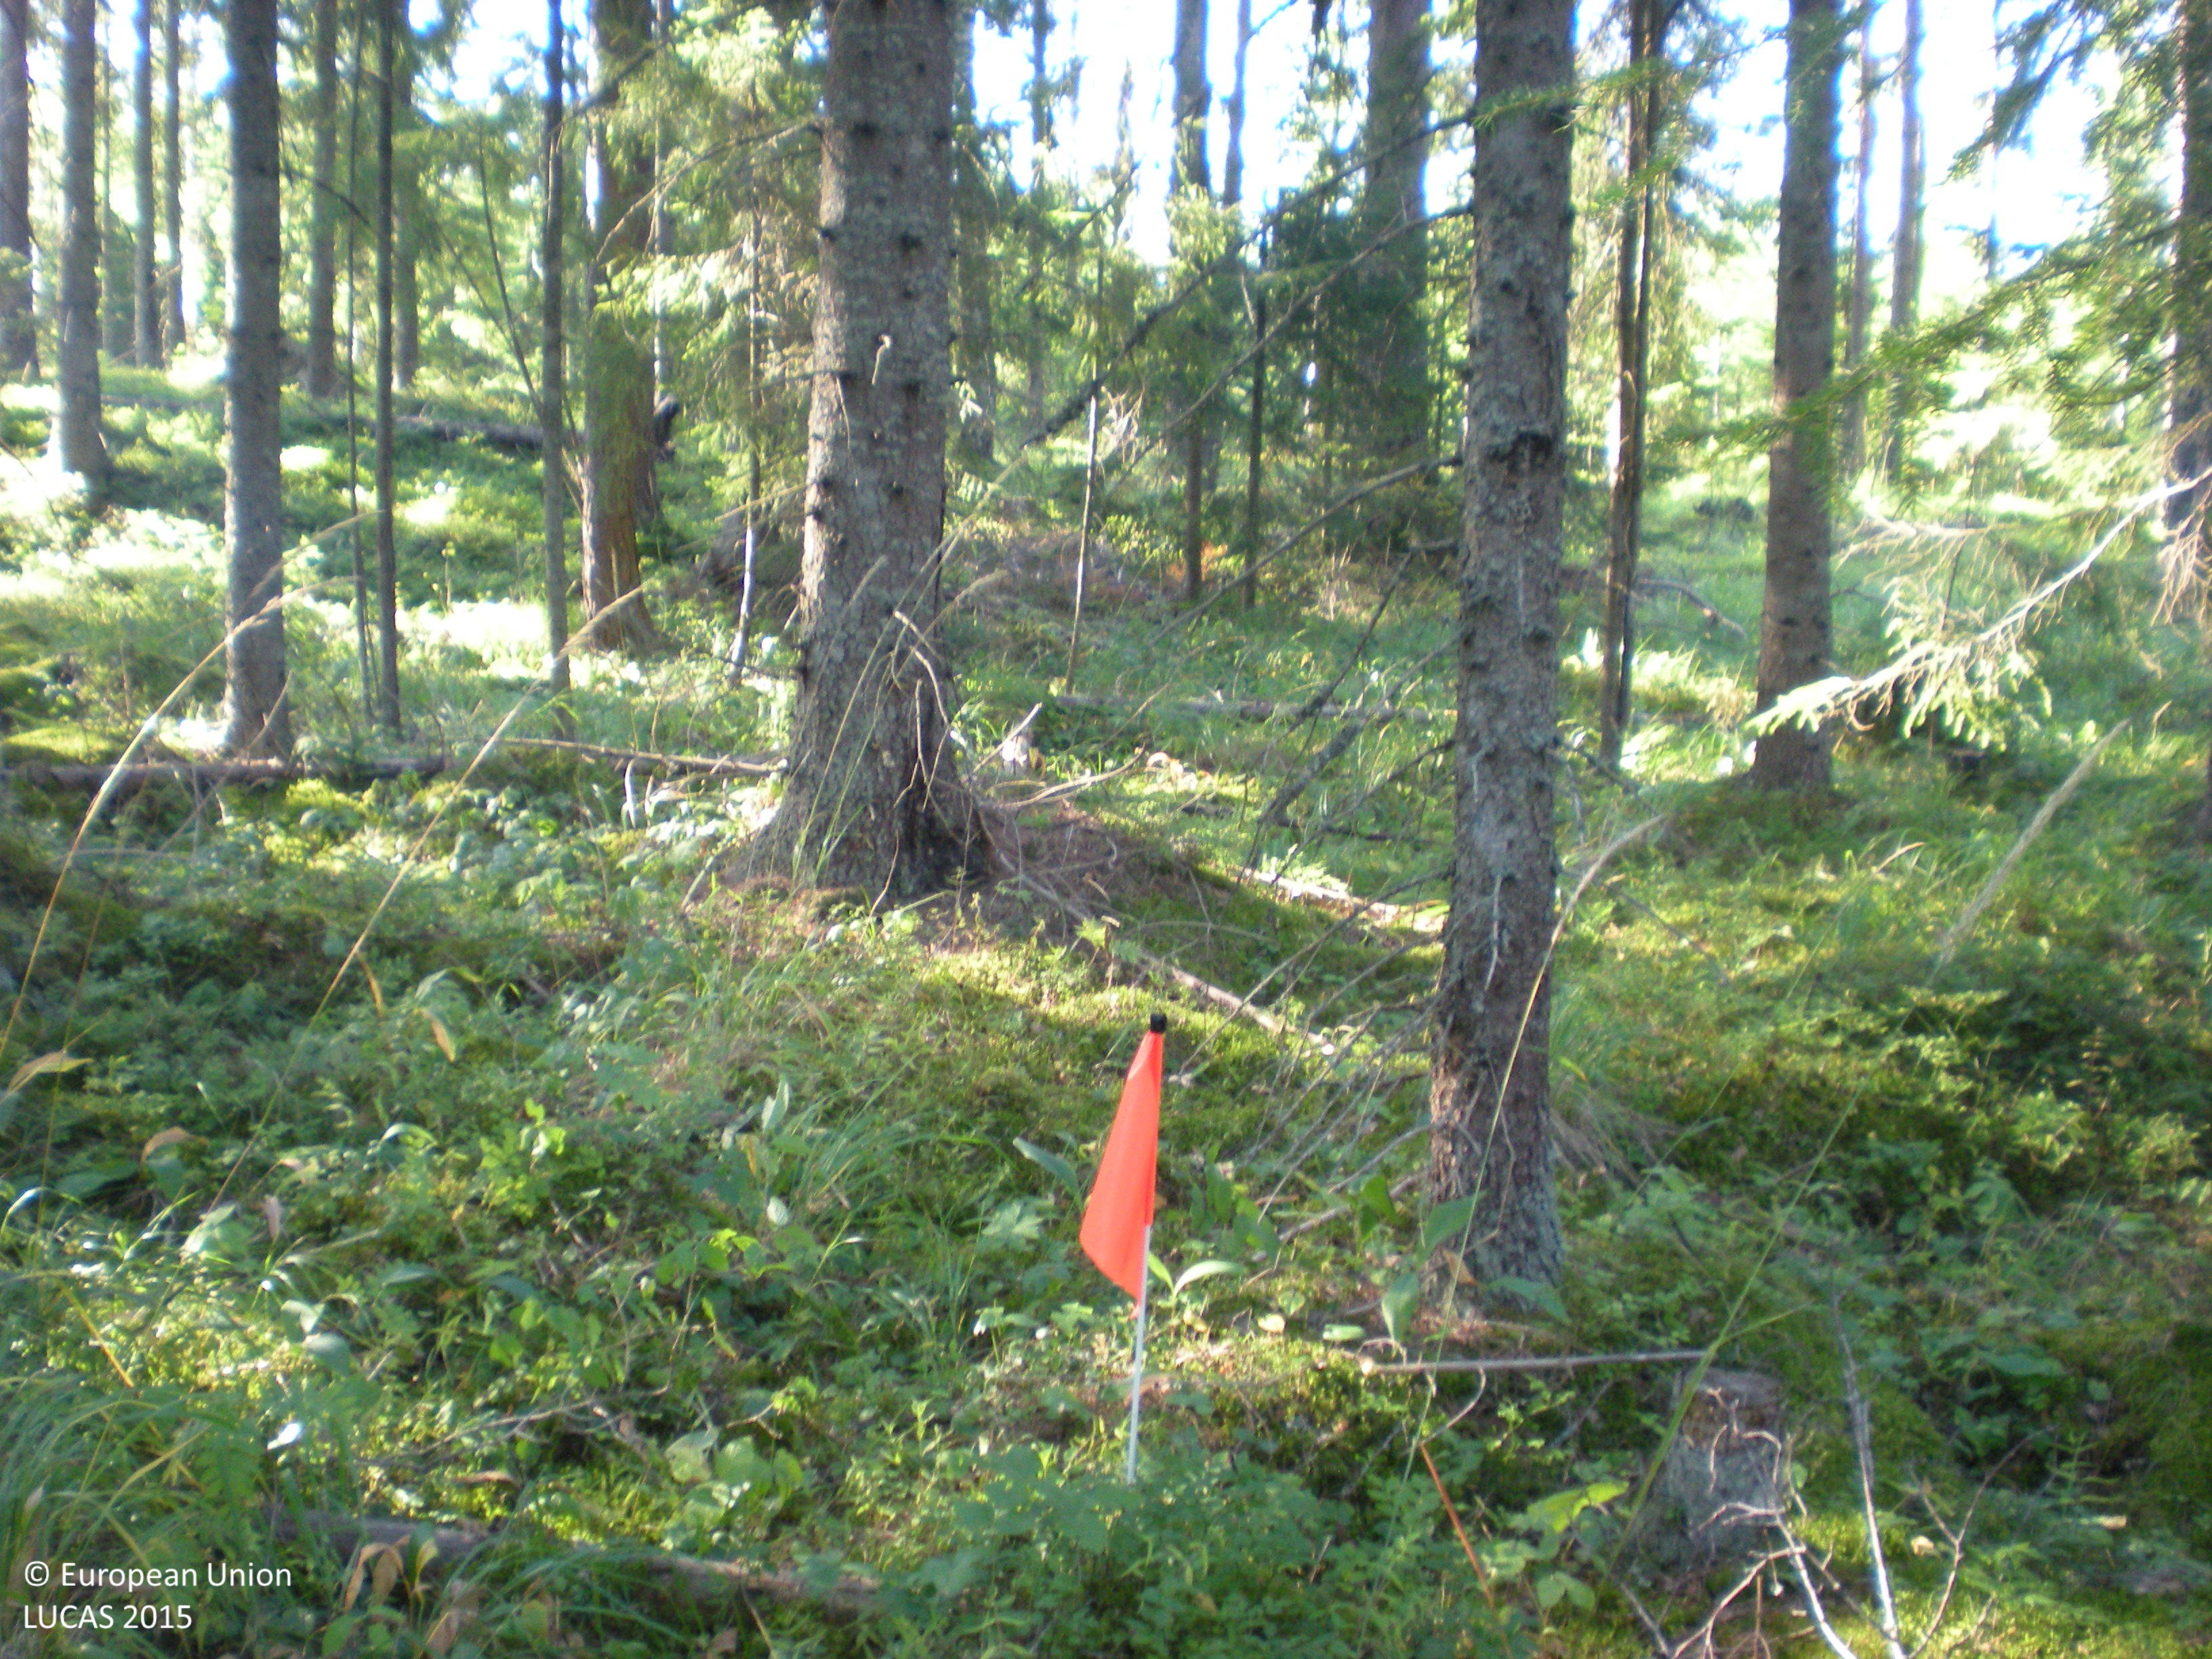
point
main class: Woodland
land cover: Spruce dominated coniferous woodland
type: boreal forest
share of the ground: 50 - 75 %
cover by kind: coniferous forest trees 70 %, herbaceous plants 10 %, lichens and mosses 10 %, broadleaved forest trees 5 %, shrubs 5 %
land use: Forestry
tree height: > 5 m
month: August
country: SE
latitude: 60.5701
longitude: 17.3062
